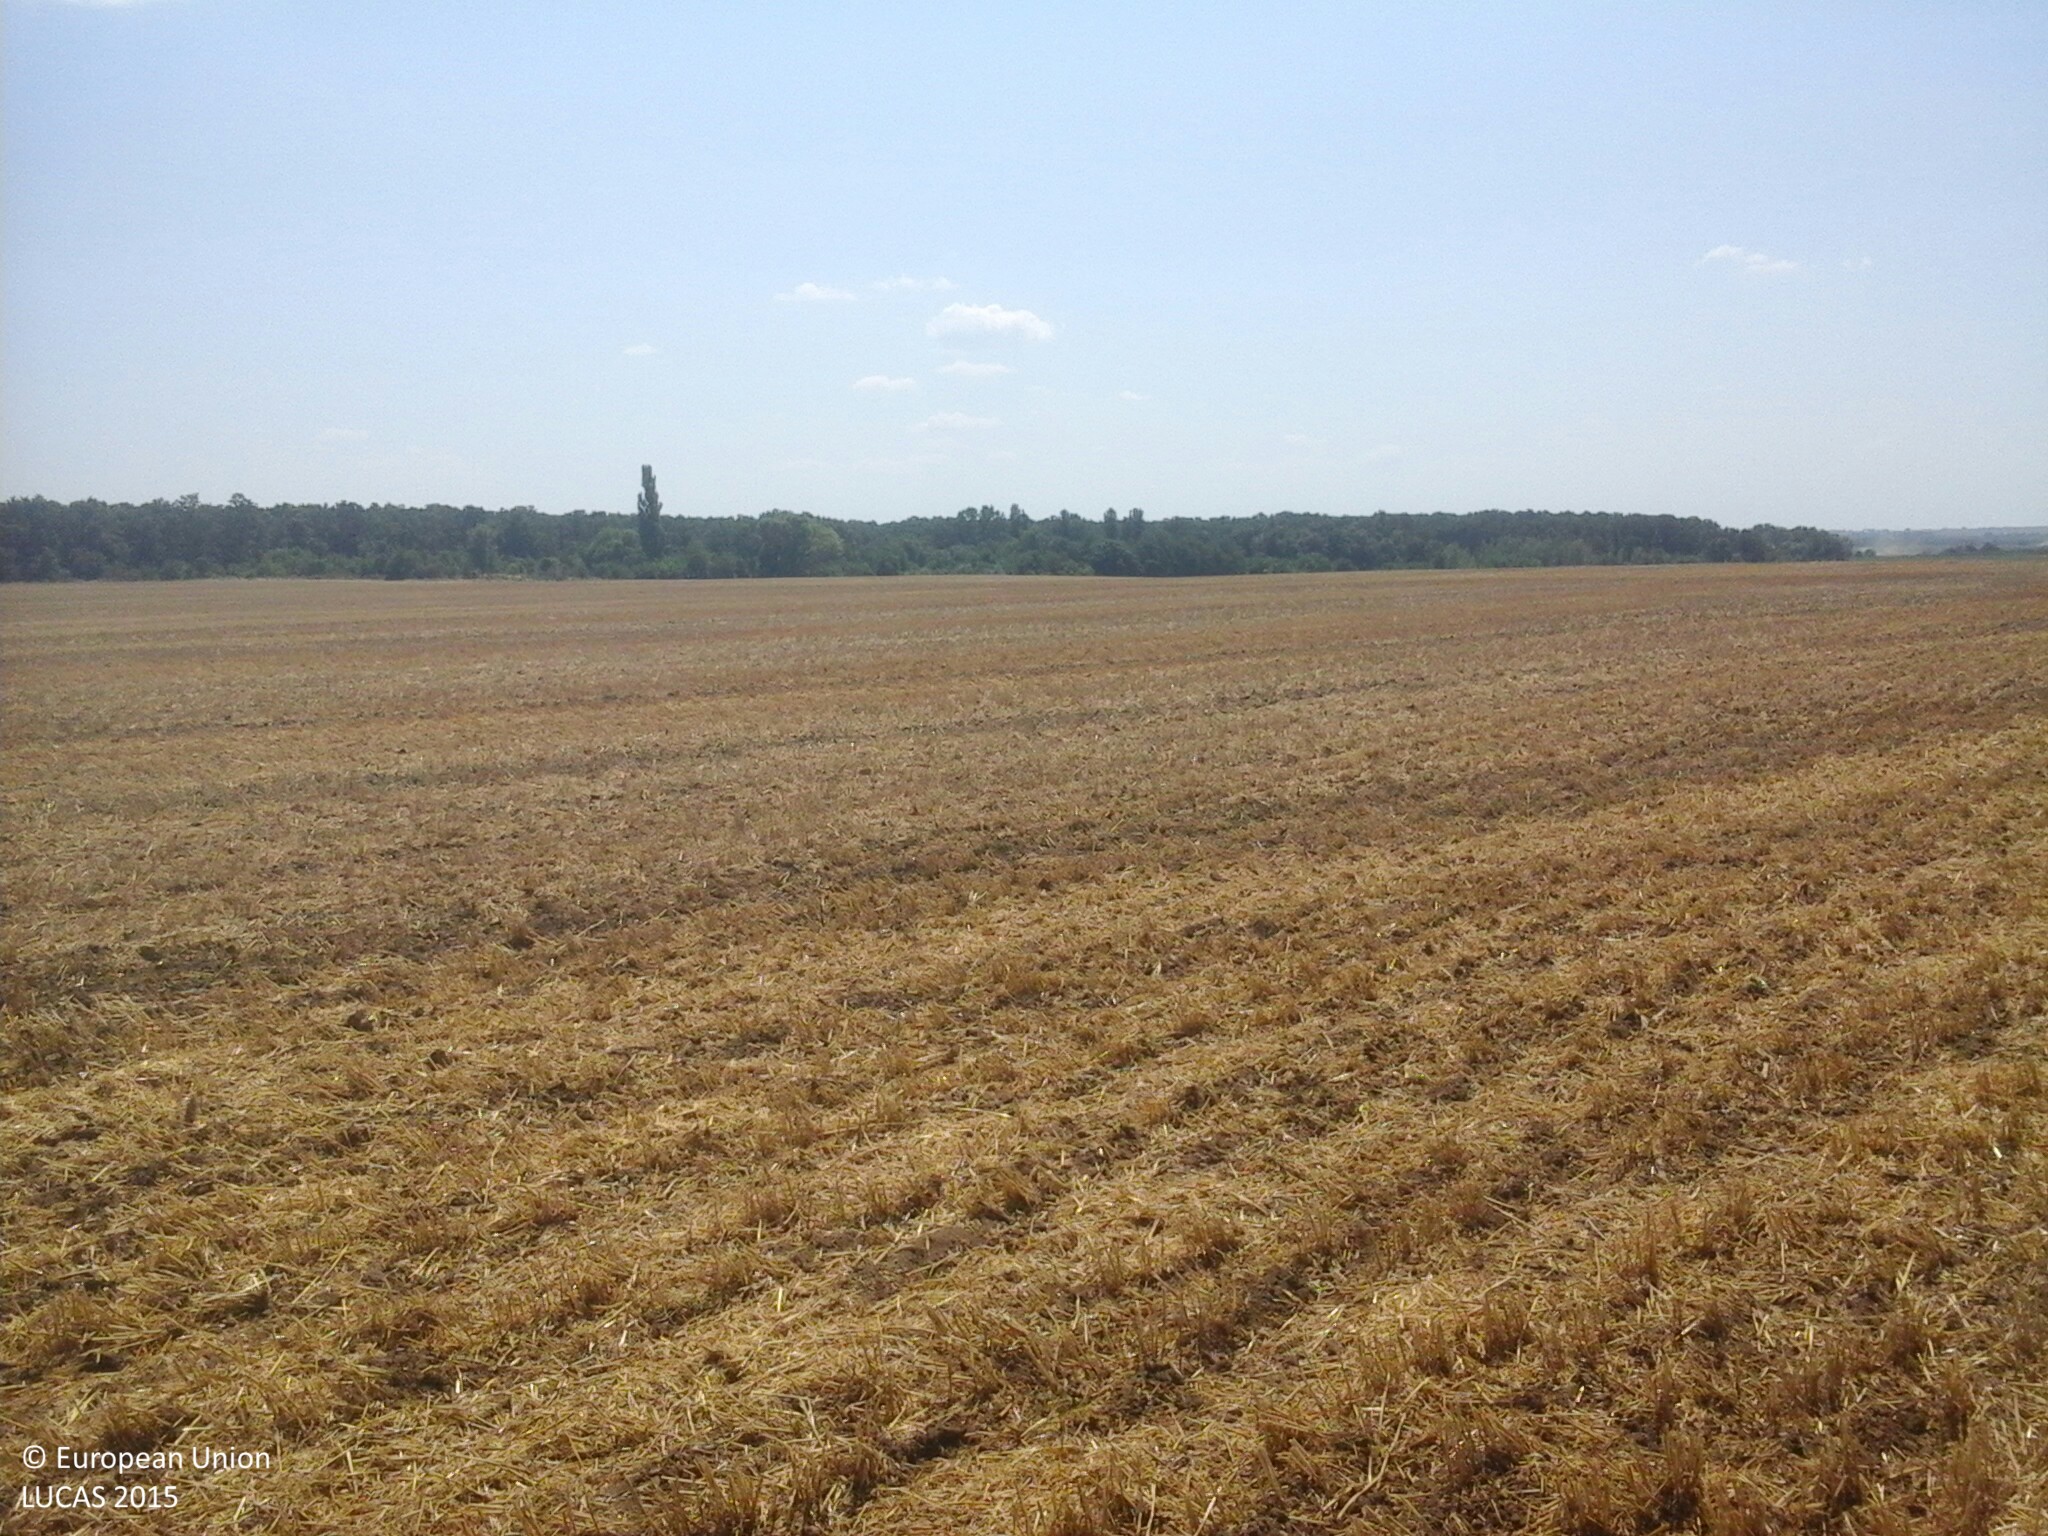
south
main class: Cropland
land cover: Common wheat
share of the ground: < 10 %
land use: Agriculture (excluding fallow land and kitchen gardens)
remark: Harvested field
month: July
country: HU
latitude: 47.1198
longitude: 18.4610
